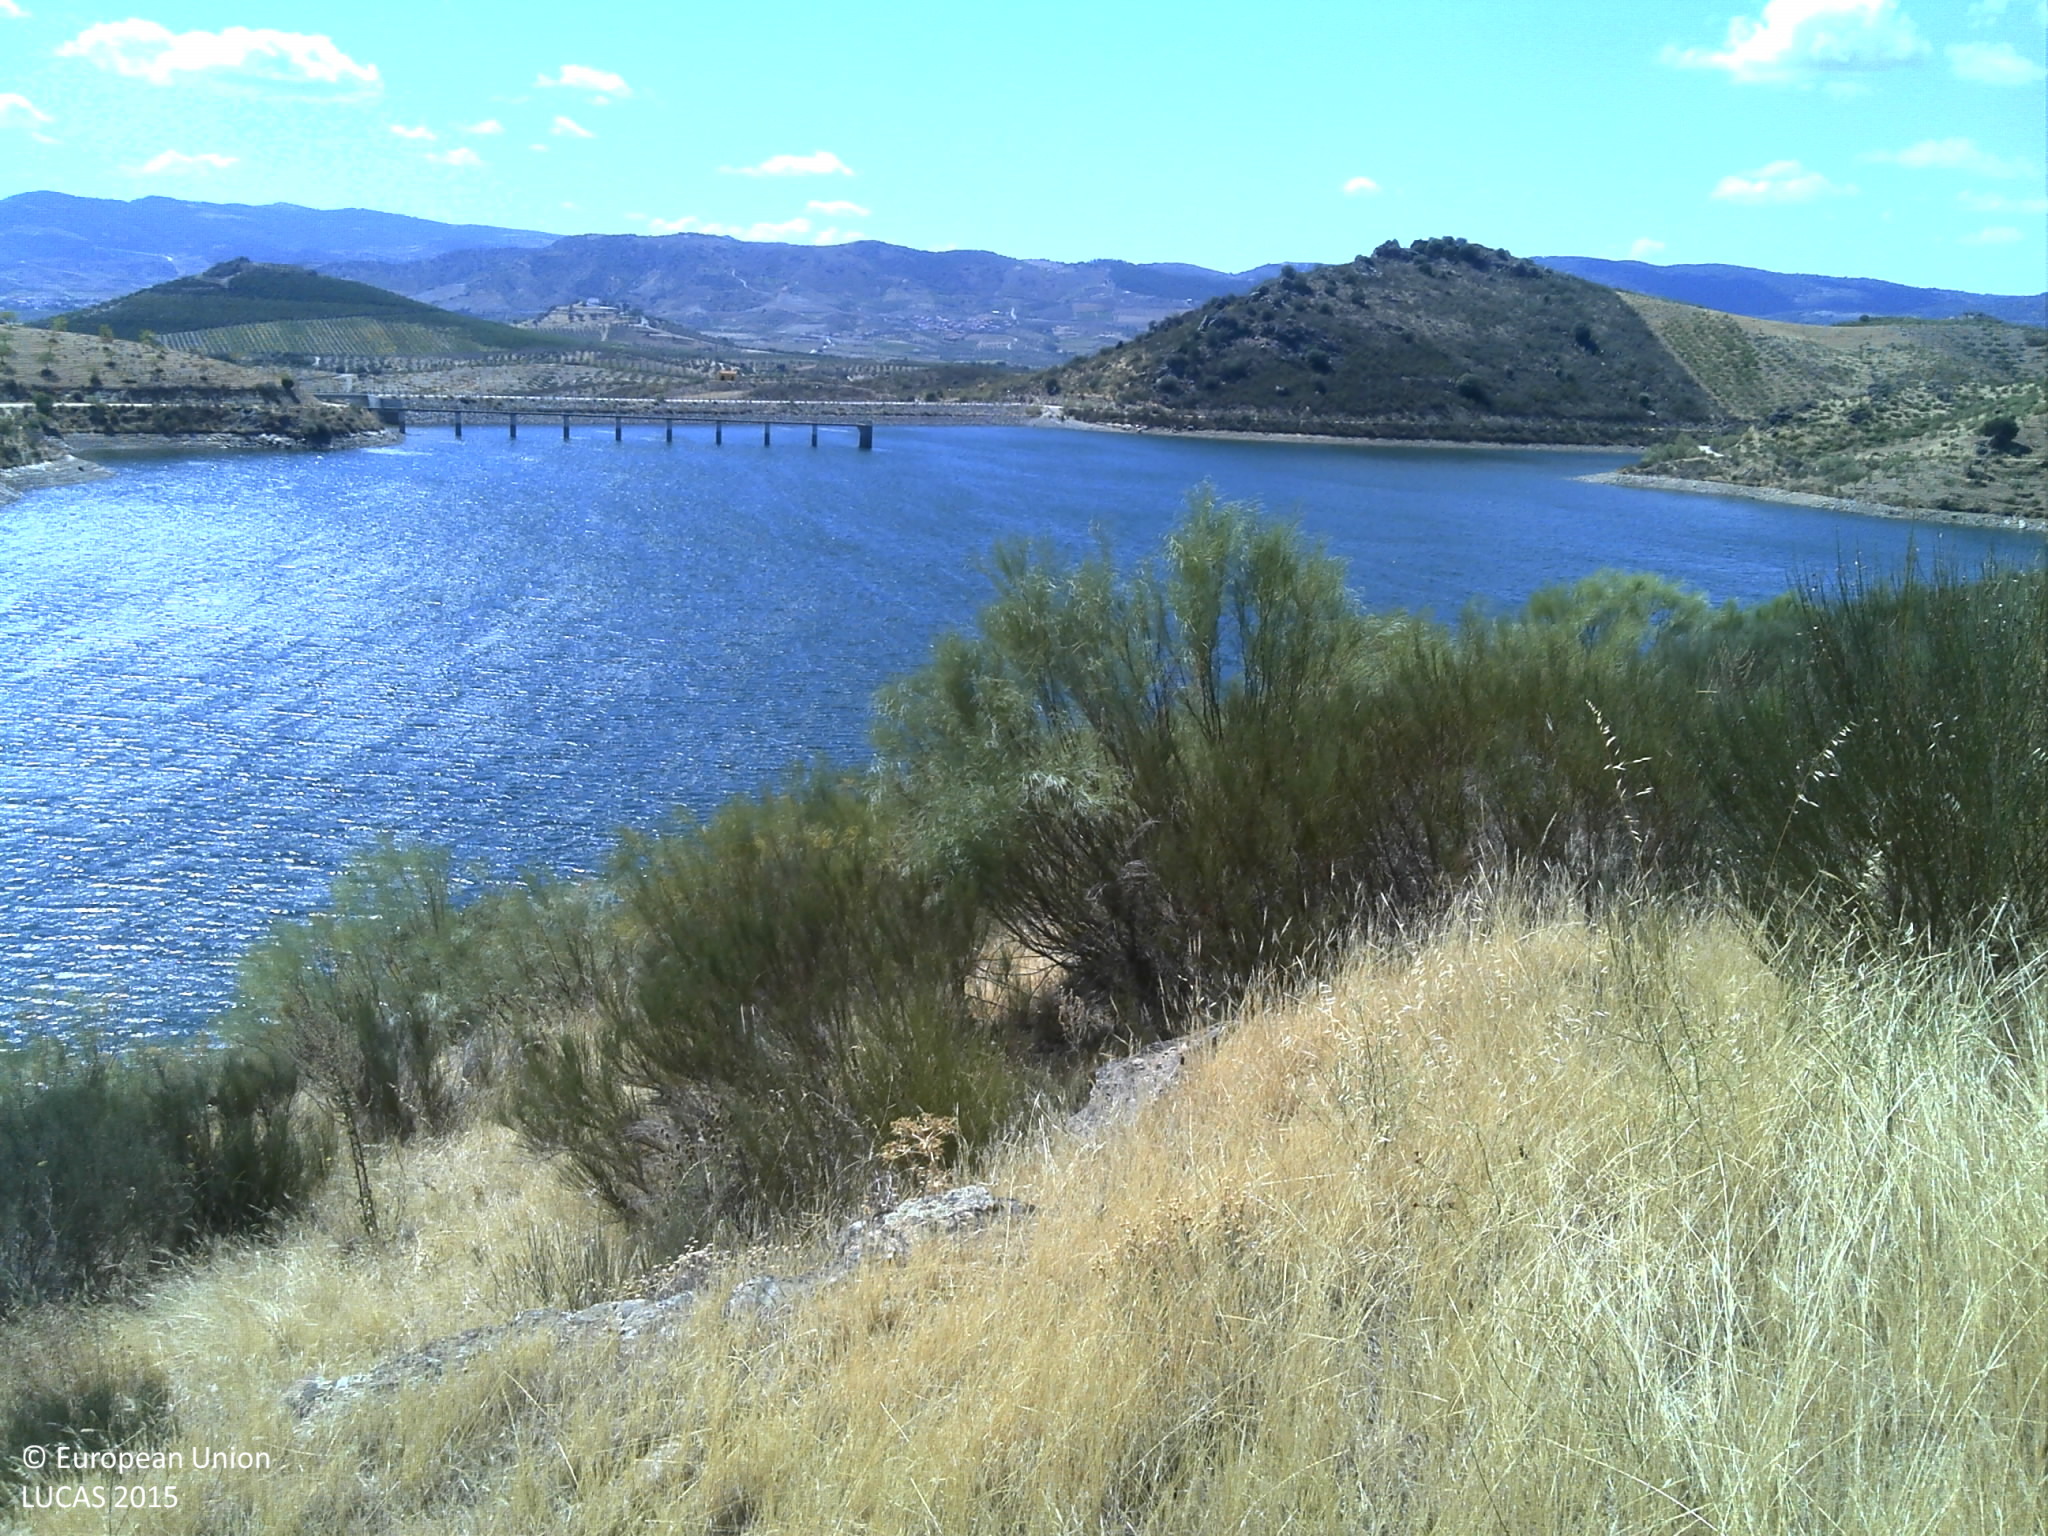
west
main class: Shrubland
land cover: Shrubland without tree cover
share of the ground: 25 - 50 %
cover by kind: herbaceous plants 55 %, shrubs 30 %, unconsolidated bare surface 10 %, consolidated bare surface 5 %
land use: Abandoned areas
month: July
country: PT
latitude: 41.3301
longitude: -7.0193
